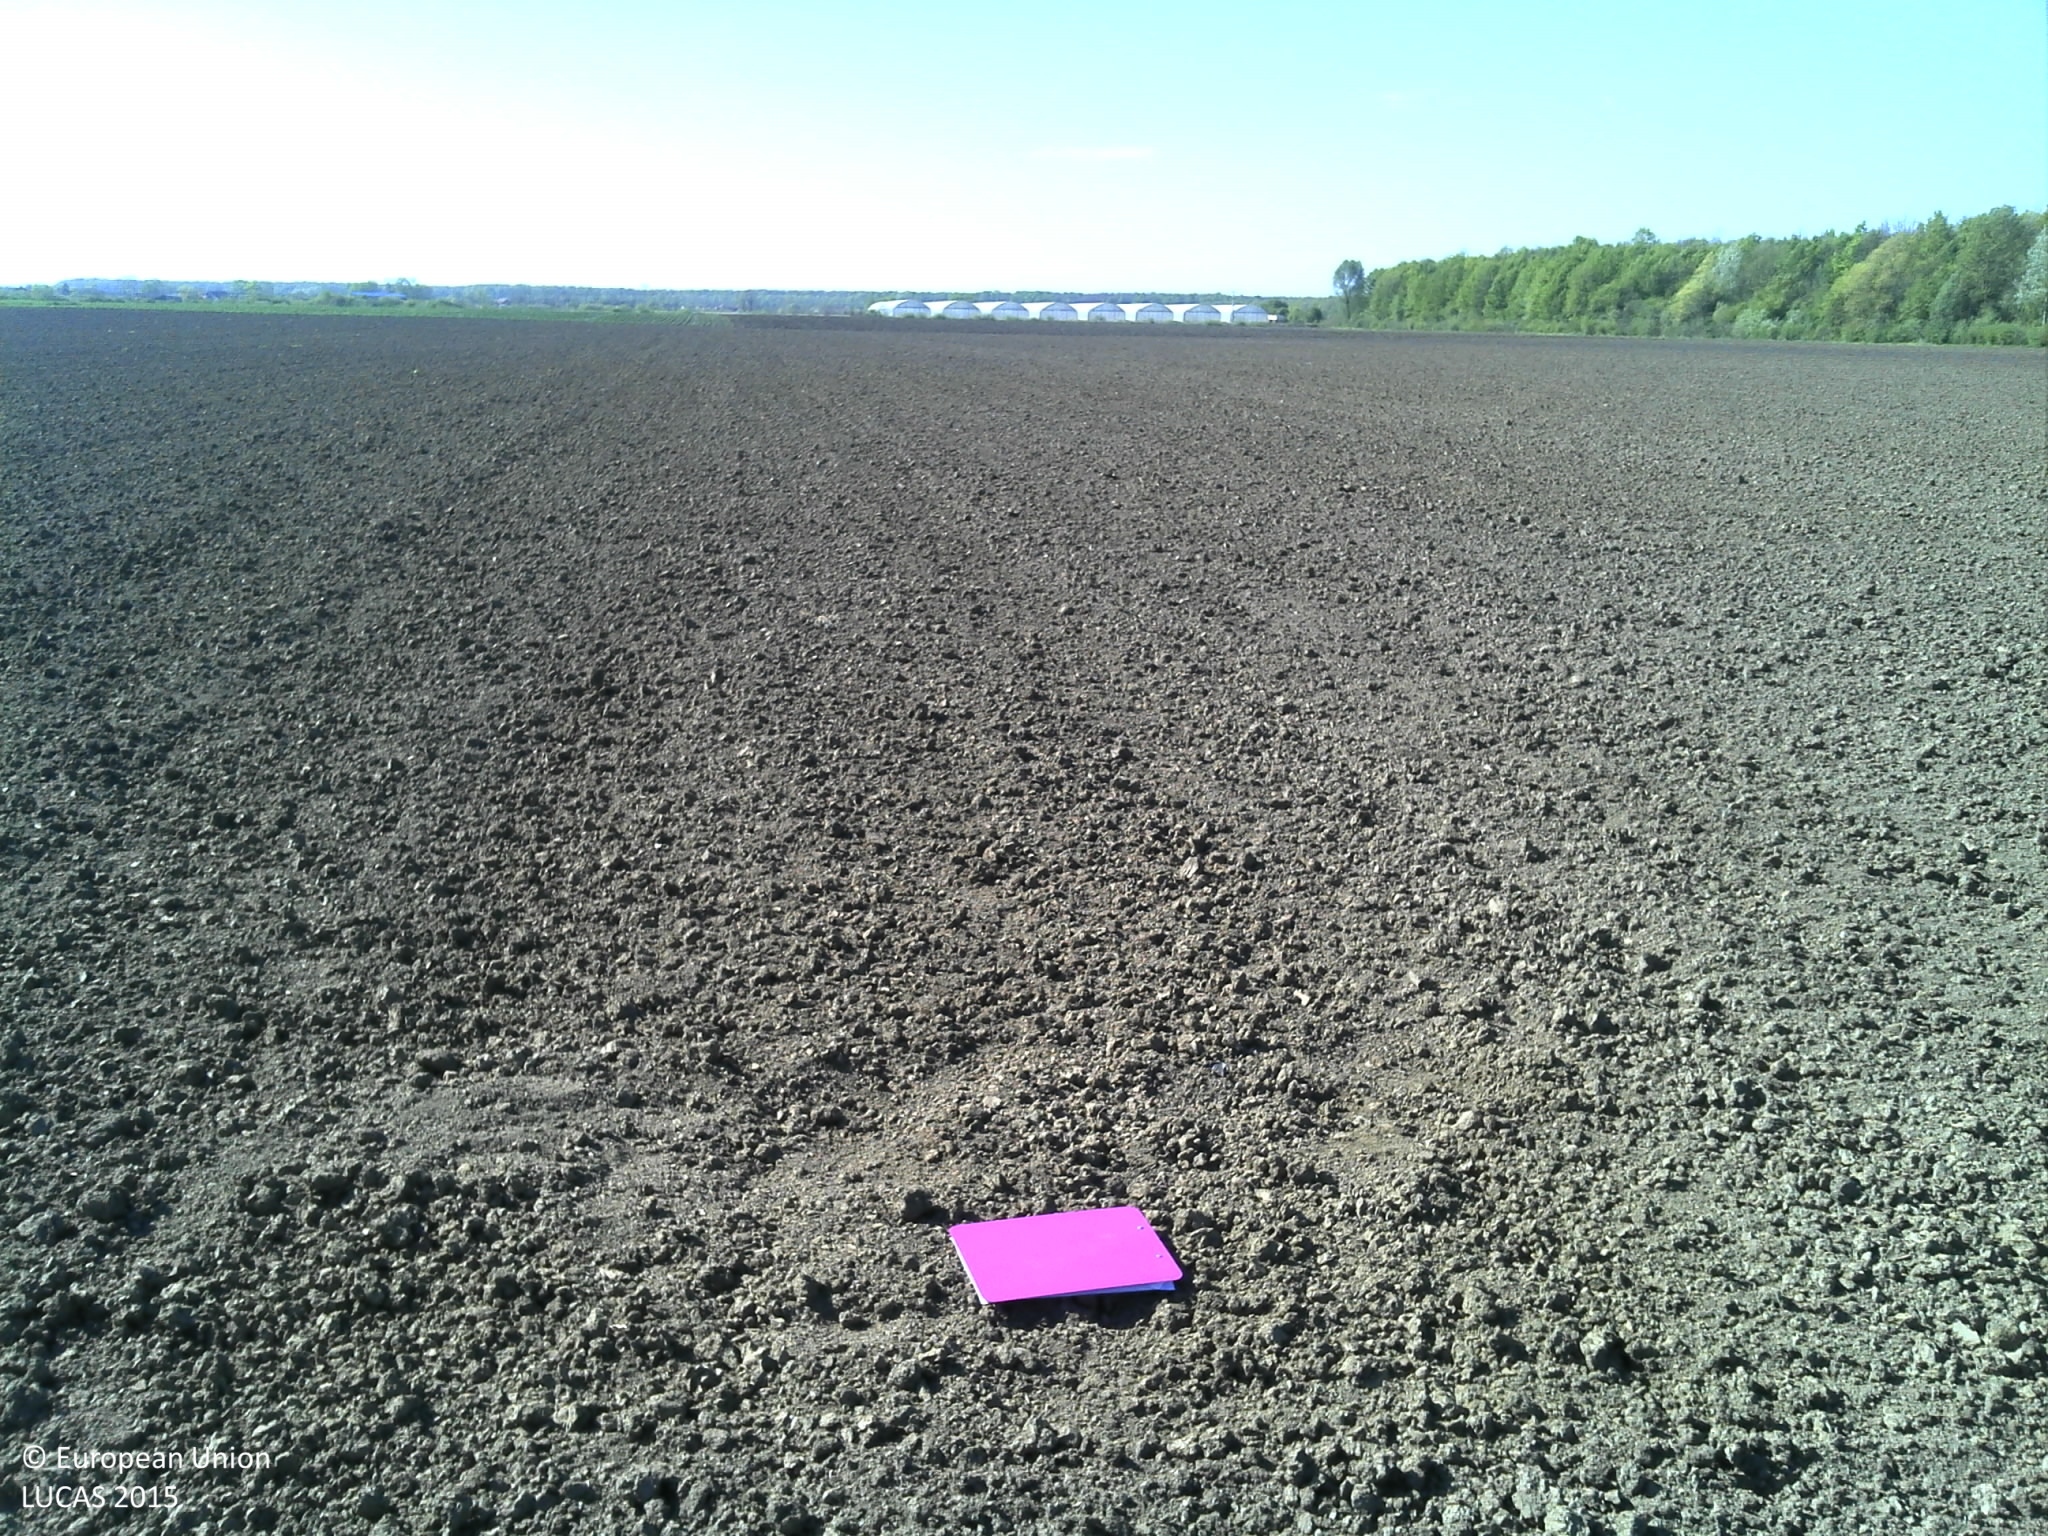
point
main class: Cropland
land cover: Soya
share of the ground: < 10 %
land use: Agriculture (excluding fallow land and kitchen gardens)
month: April
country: HR
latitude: 45.2253
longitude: 18.6025
